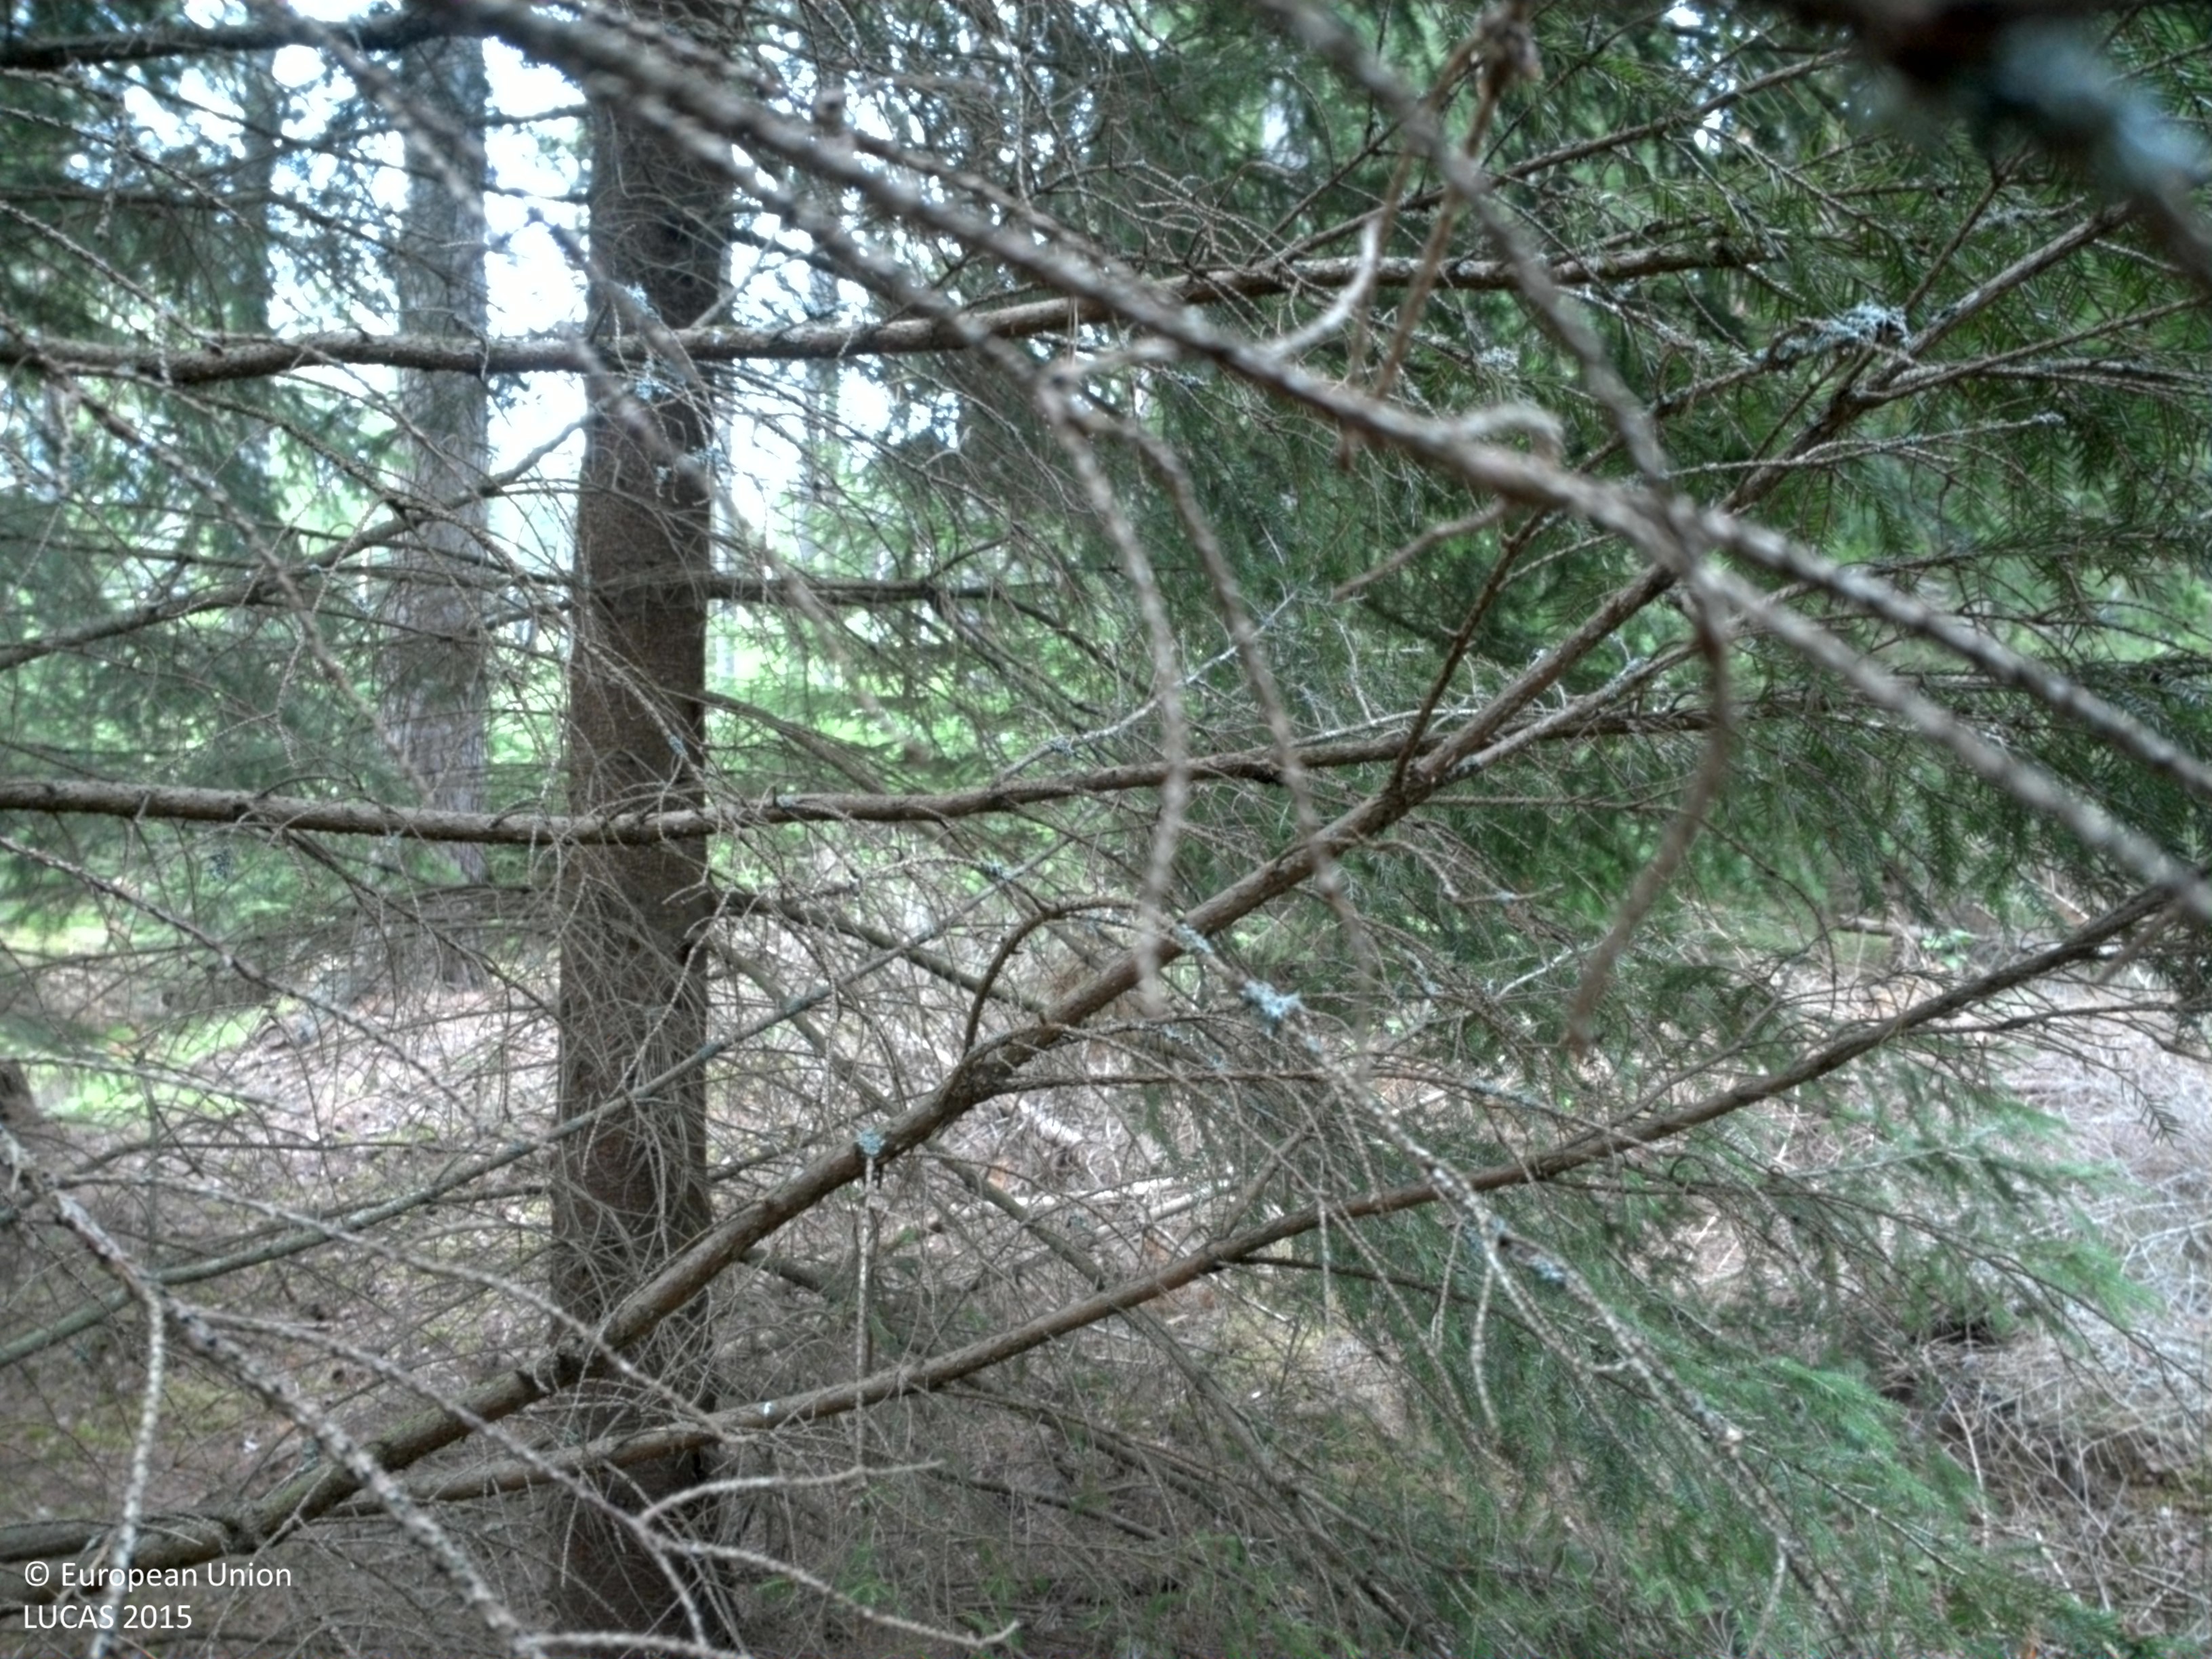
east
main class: Woodland
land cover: Spruce dominated coniferous woodland
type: boreal forest
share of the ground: > 75 %
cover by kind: coniferous forest trees 85 %, unconsolidated bare surface 10 %, lichens and mosses 5 %
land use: Forestry
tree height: > 5 m
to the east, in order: Spruce dominated coniferous woodland; Pine dominated coniferous woodland; Spruce dominated coniferous woodland; Tracks; Pine dominated coniferous woodland; Ditches and canals; Spruce dominated mixed woodland
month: July
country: SE
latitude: 58.3592
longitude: 13.2928
